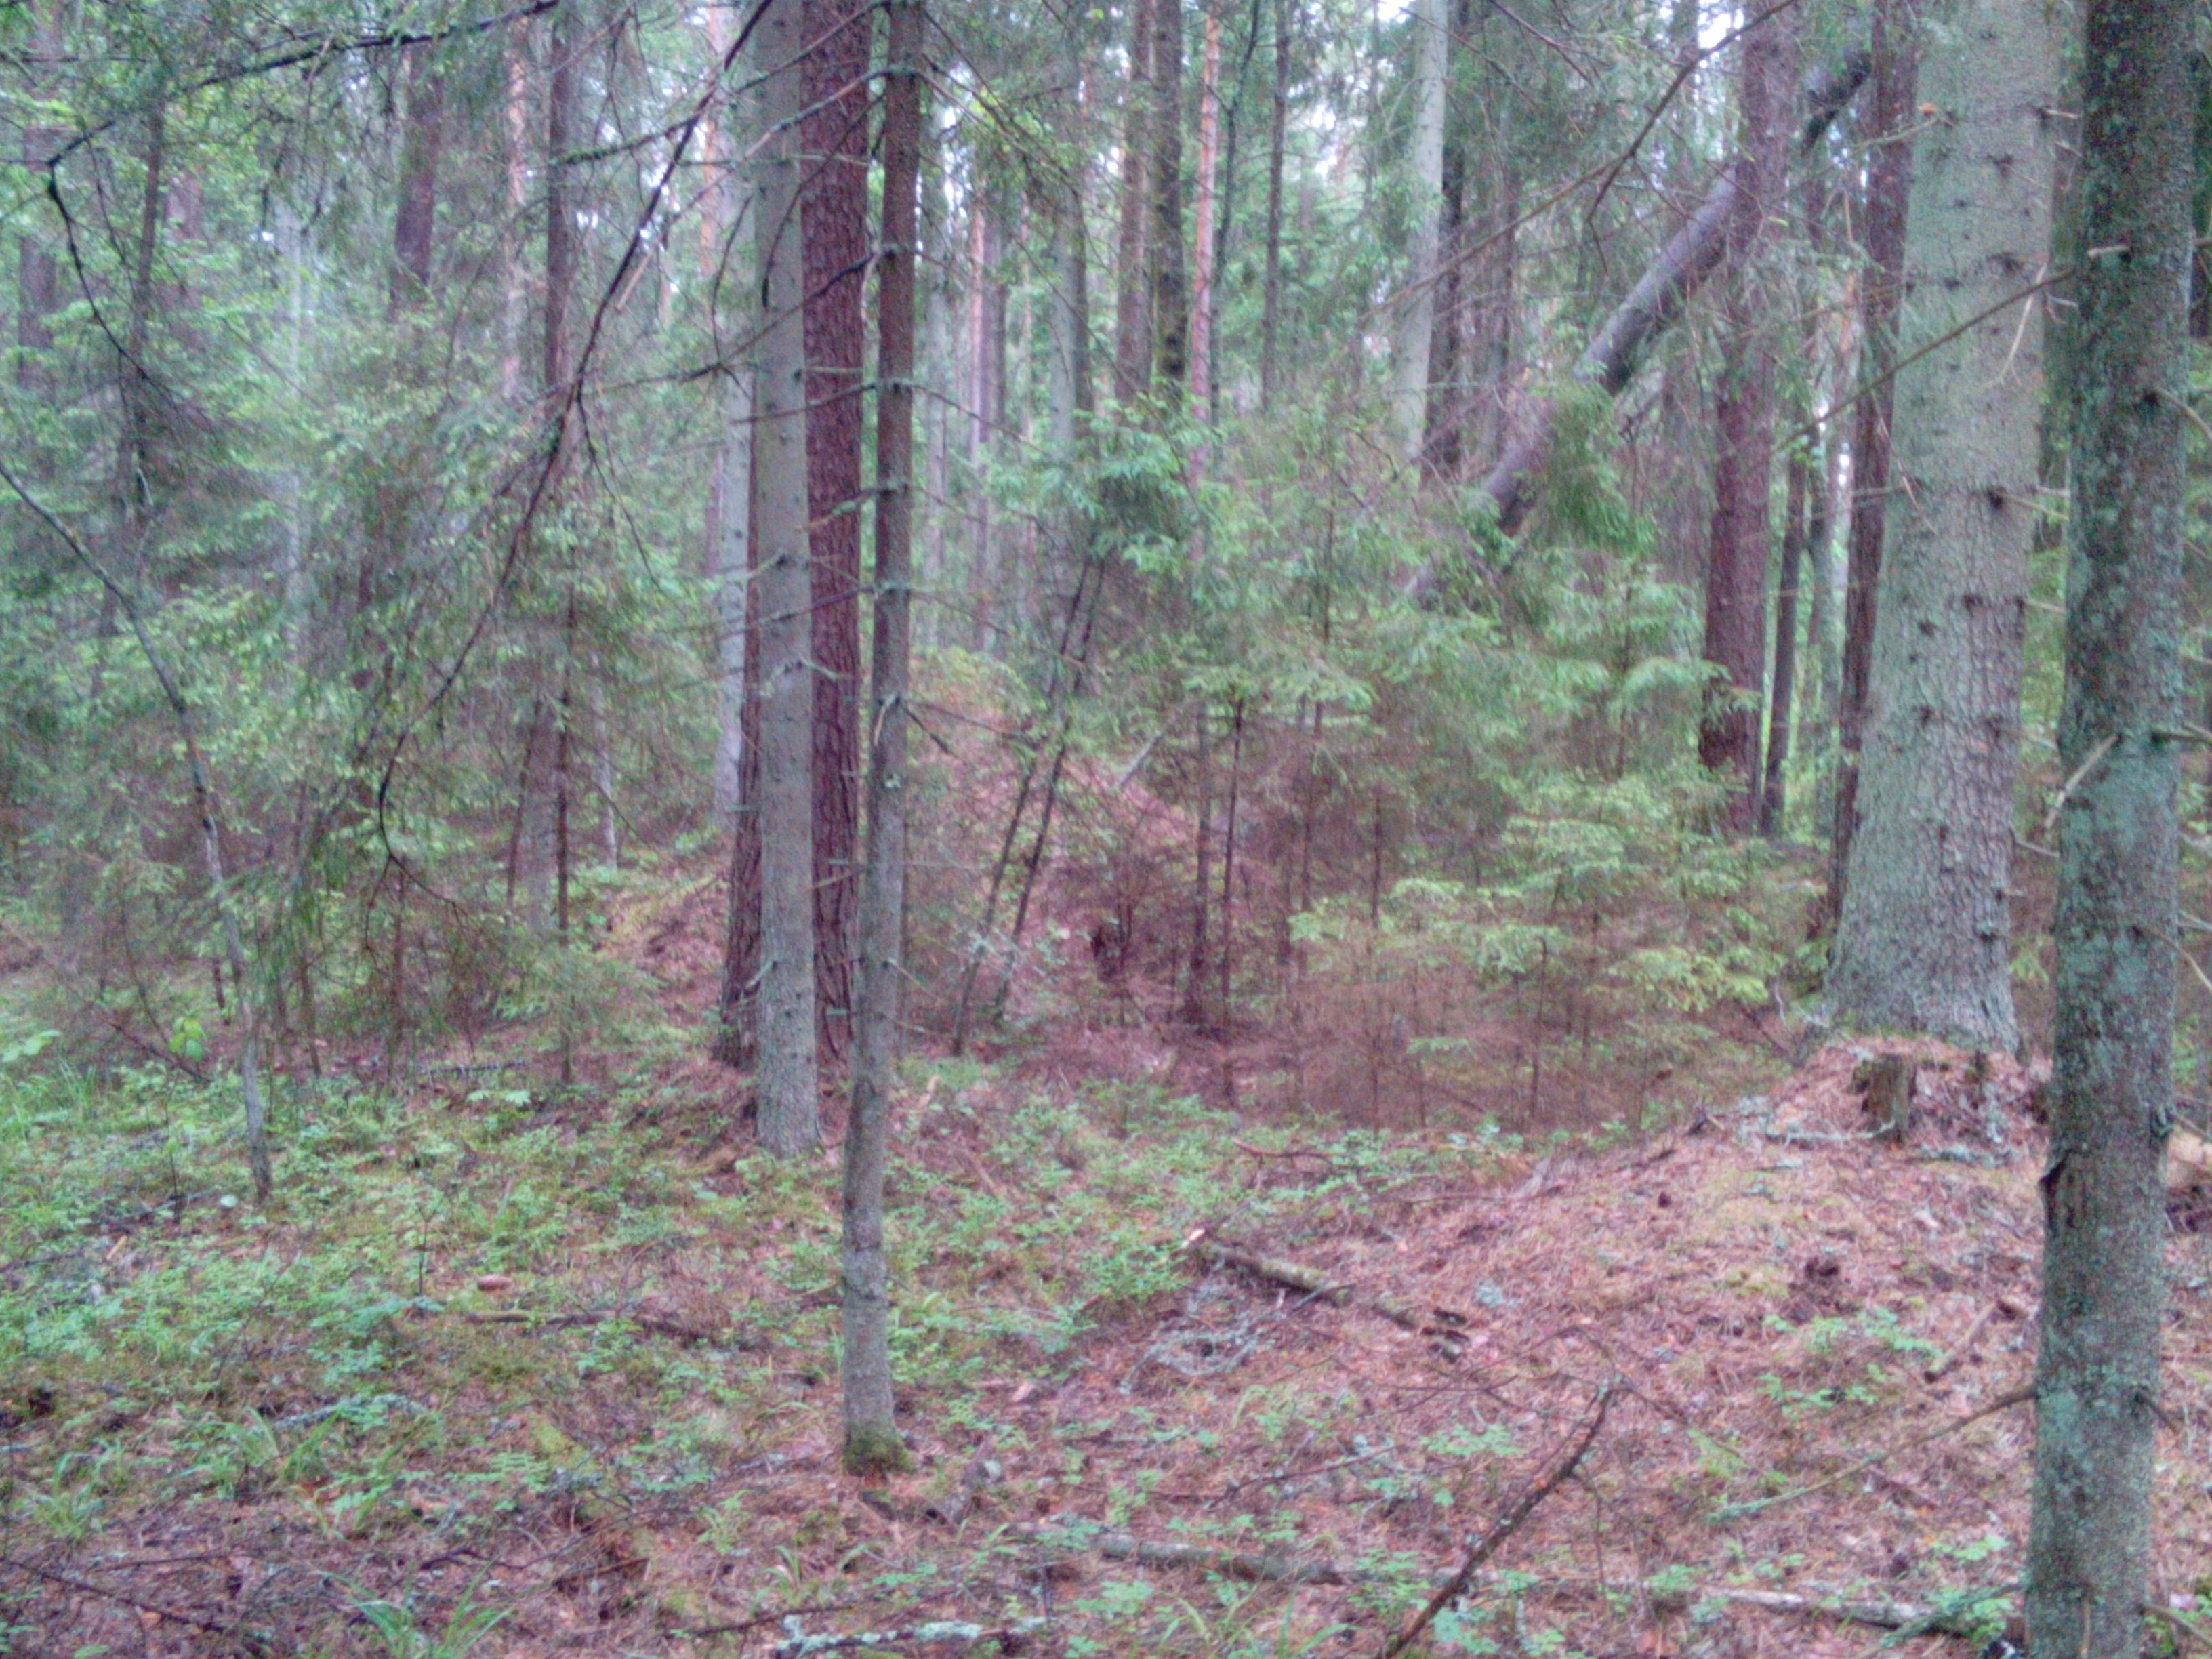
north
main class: Woodland
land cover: Other coniferous woodland
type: hemiboreal forest and nemoral coniferous forest and mixed broadleaved-coniferous forest
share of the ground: > 75 %
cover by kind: coniferous forest trees 90 %, herbaceous plants 10 %
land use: Forestry
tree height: > 5 m
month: June
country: LV
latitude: 56.7712
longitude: 21.9761
